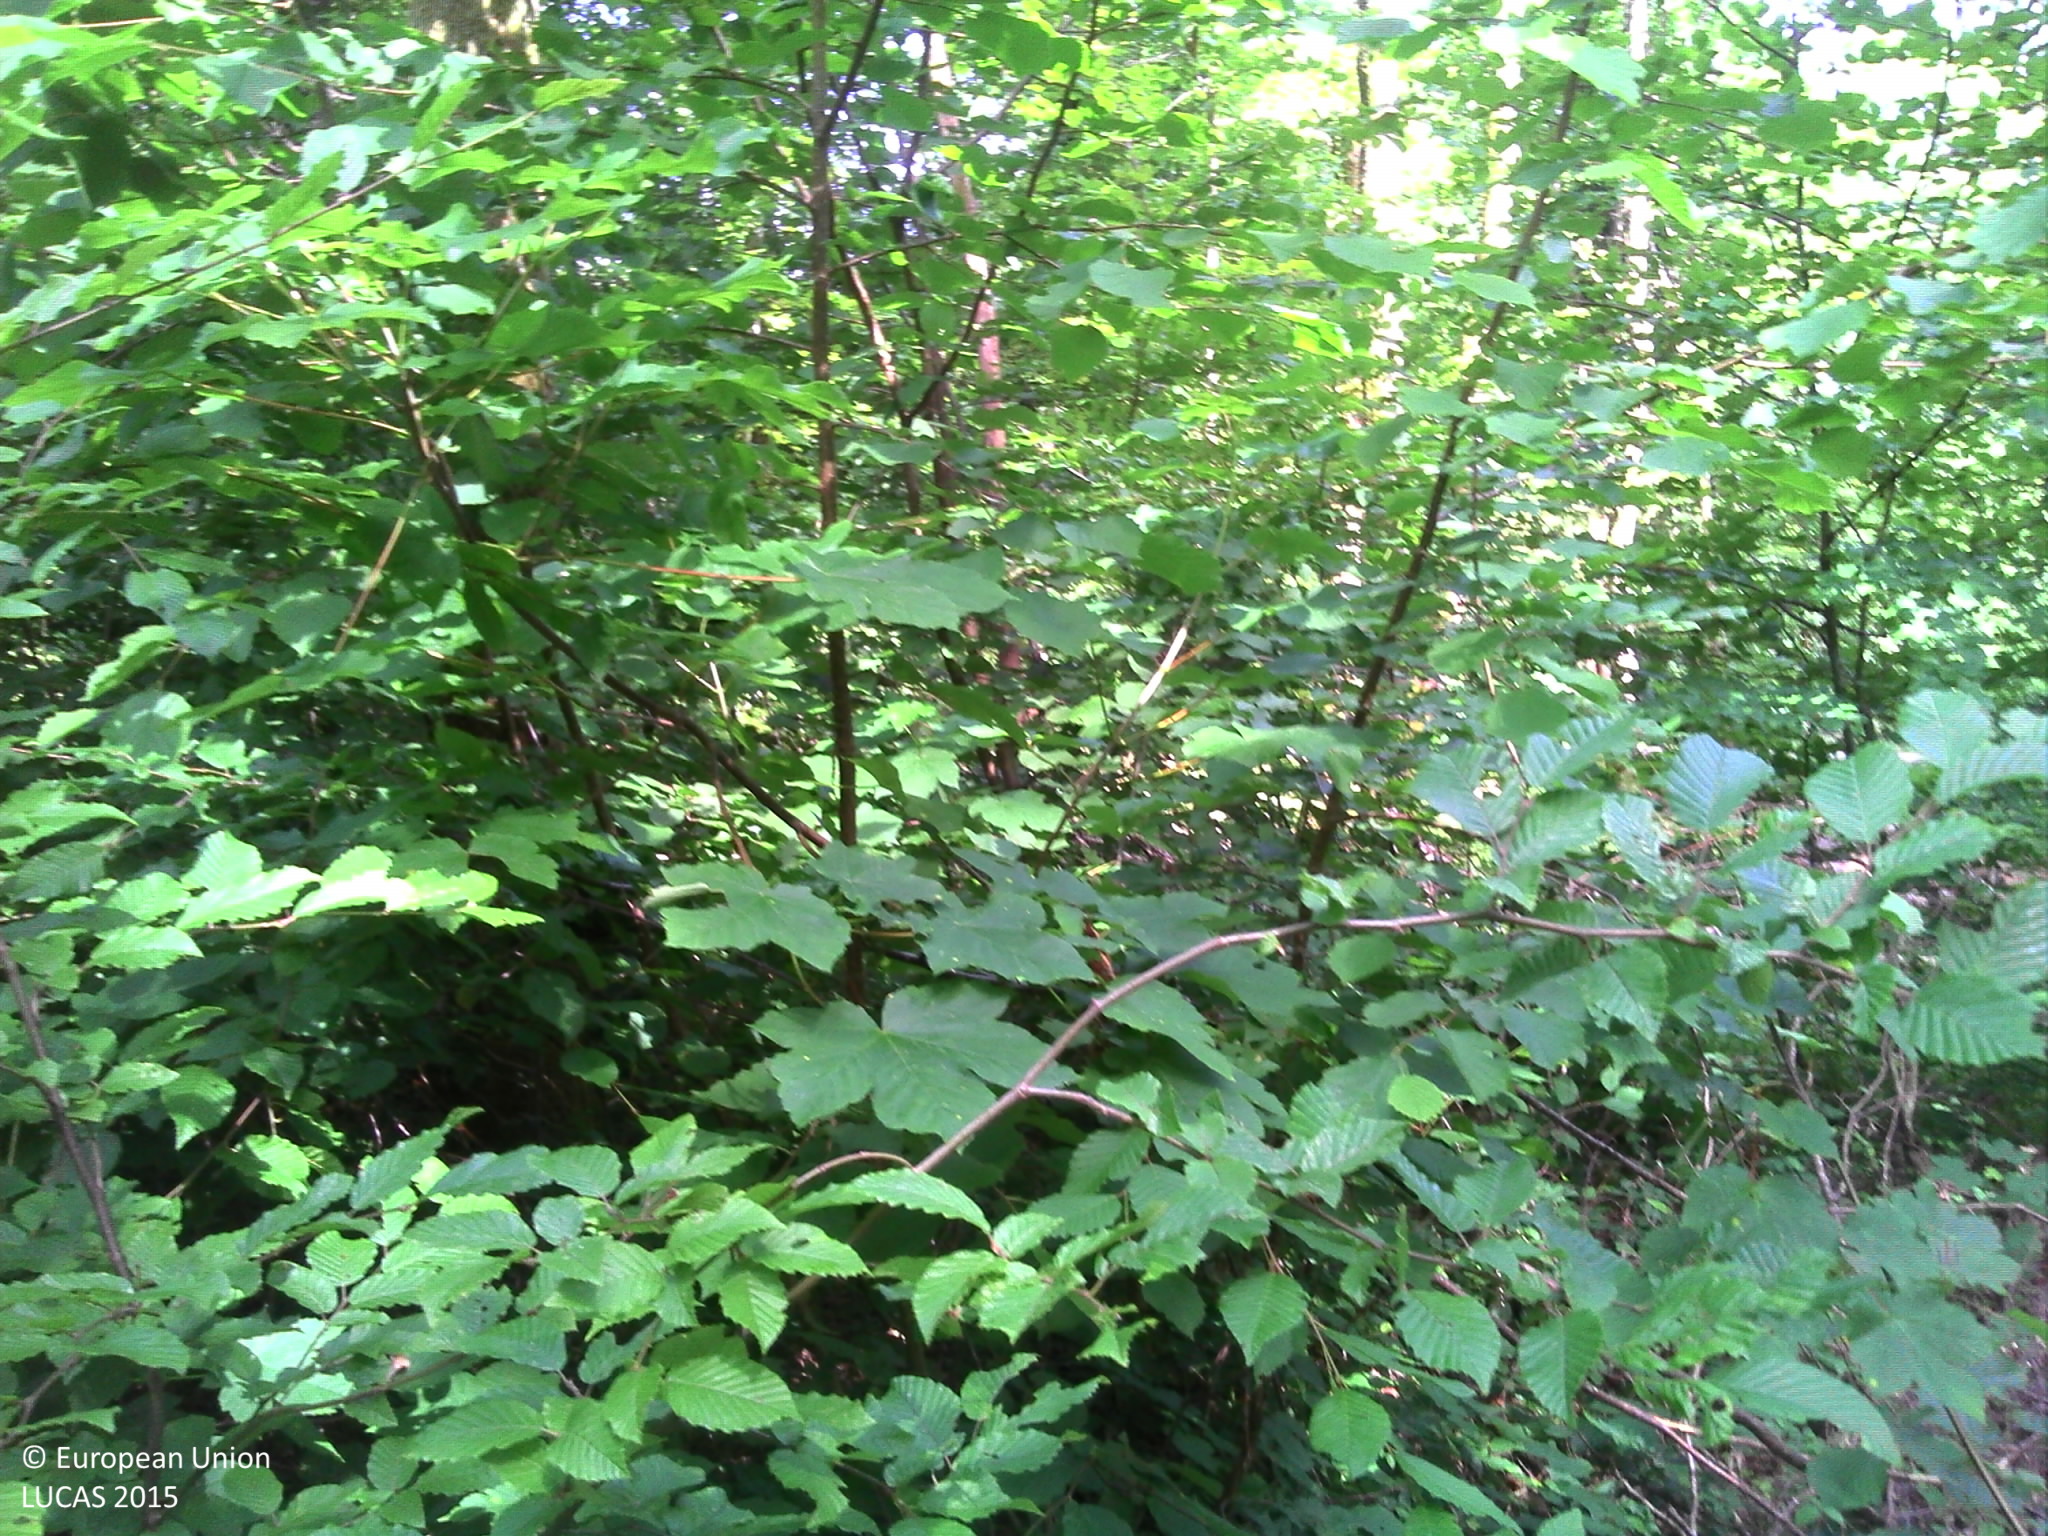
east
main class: Woodland
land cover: Broadleaved woodland
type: mesophytic deciduous forest
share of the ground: > 75 %
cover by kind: broadleaved forest trees 80 %, shrubs 20 %
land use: Forestry
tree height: > 5 m
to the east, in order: Broadleaved woodland; Grass margins; Tracks; Grass margins; Broadleaved woodland
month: June
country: FR
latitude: 48.7295
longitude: 5.1449
